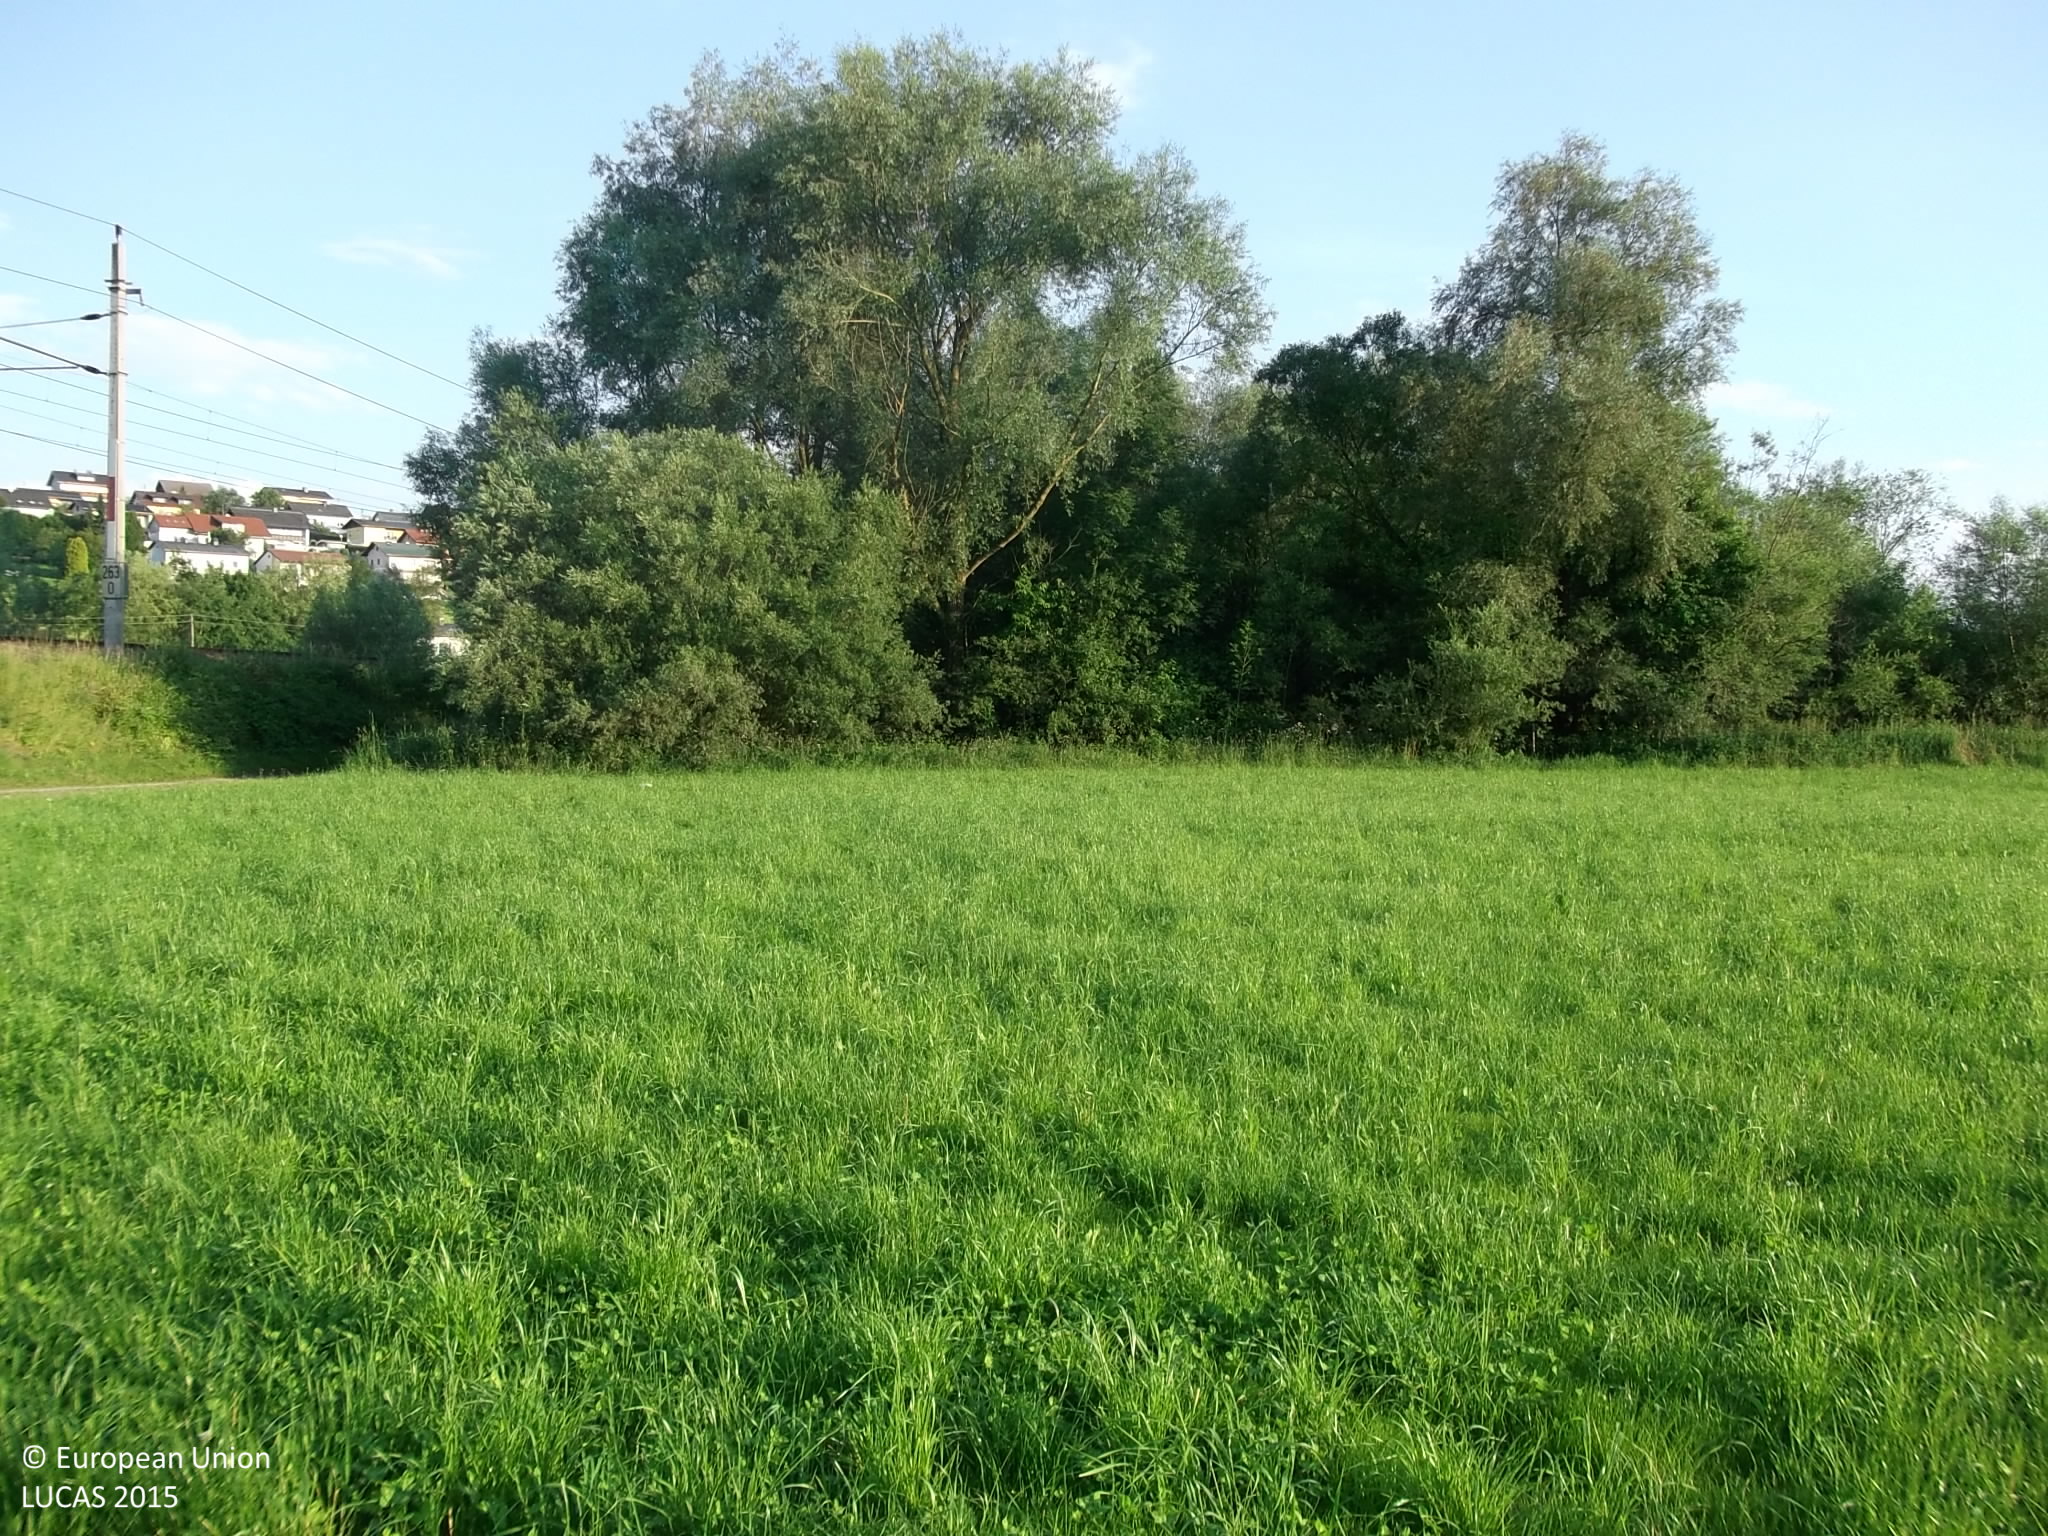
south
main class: Grassland
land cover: Grassland without tree/shrub cover
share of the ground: > 75 %
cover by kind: herbaceous plants 100 %
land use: Agriculture (excluding fallow land and kitchen gardens)
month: June
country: AT
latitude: 48.0060
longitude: 13.4975
